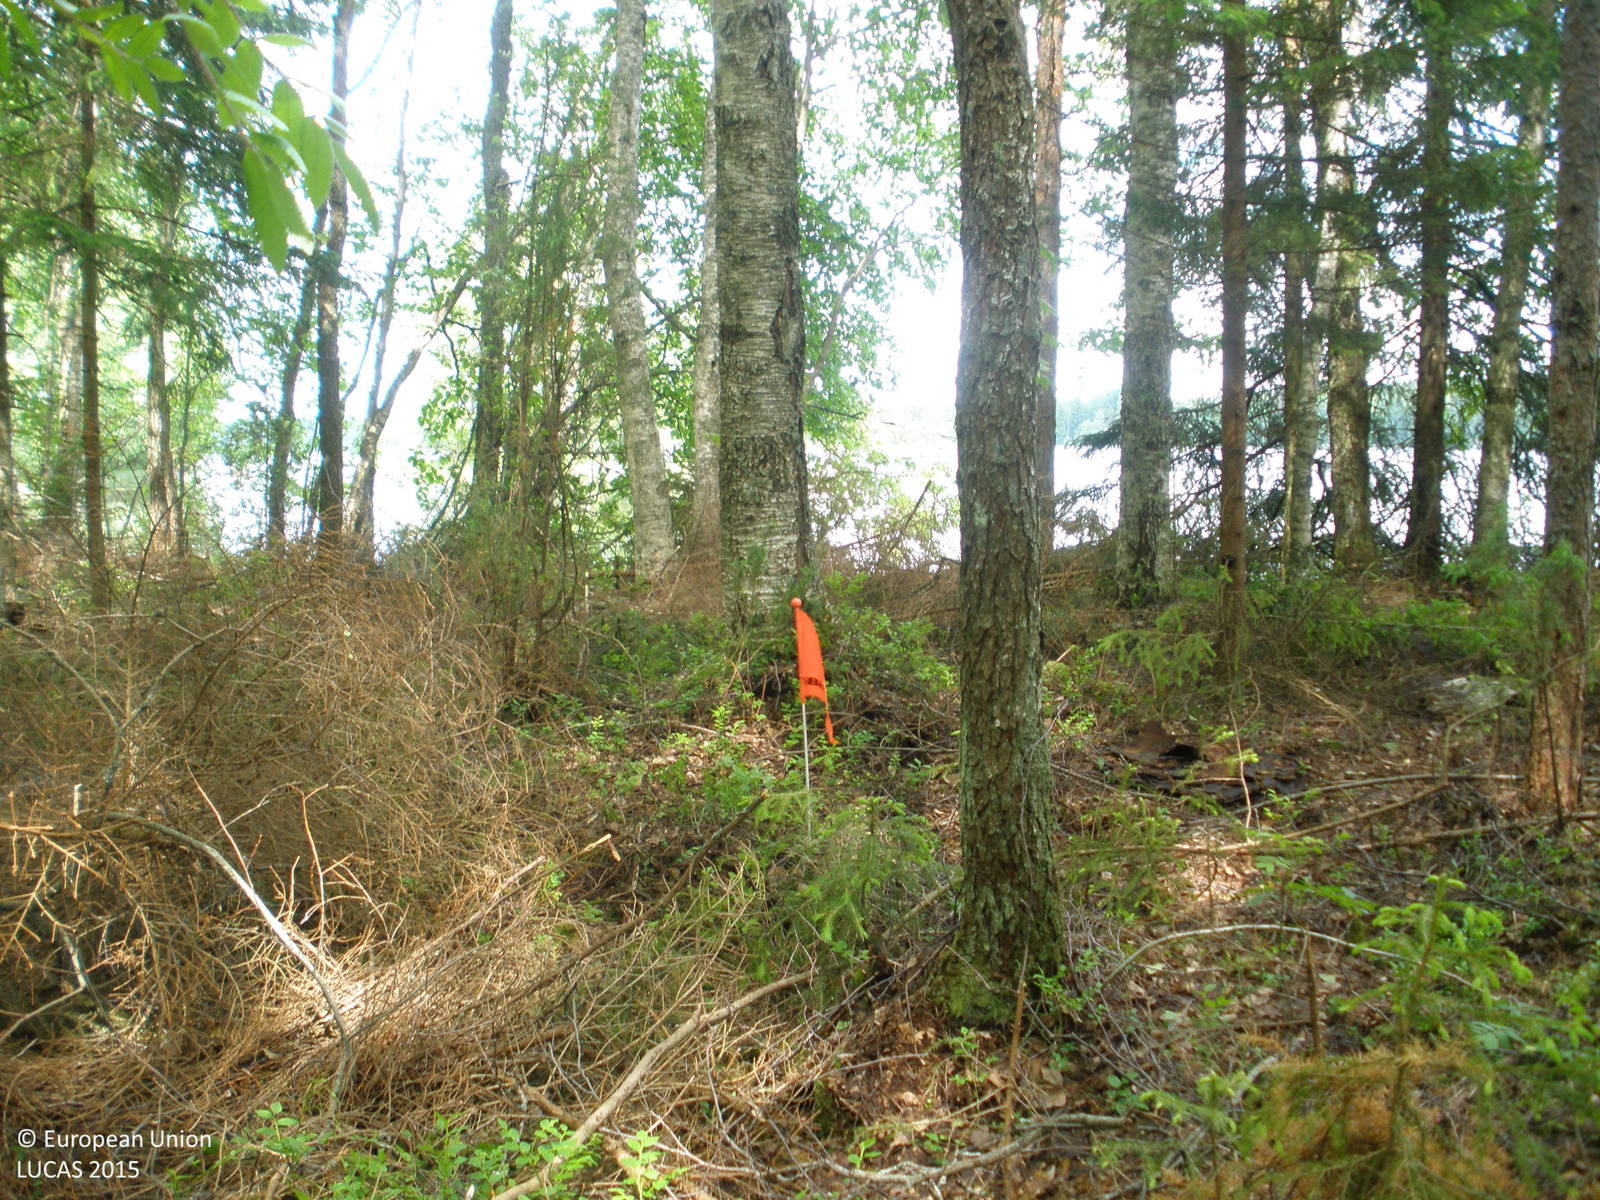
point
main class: Woodland
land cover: Spruce dominated mixed woodland
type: boreal forest
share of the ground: > 75 %
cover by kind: broadleaved forest trees 50 %, coniferous forest trees 35 %, herbaceous plants 10 %, shrubs 5 %
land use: Forestry
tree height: > 5 m
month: June
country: FI
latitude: 61.0011
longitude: 23.6023
